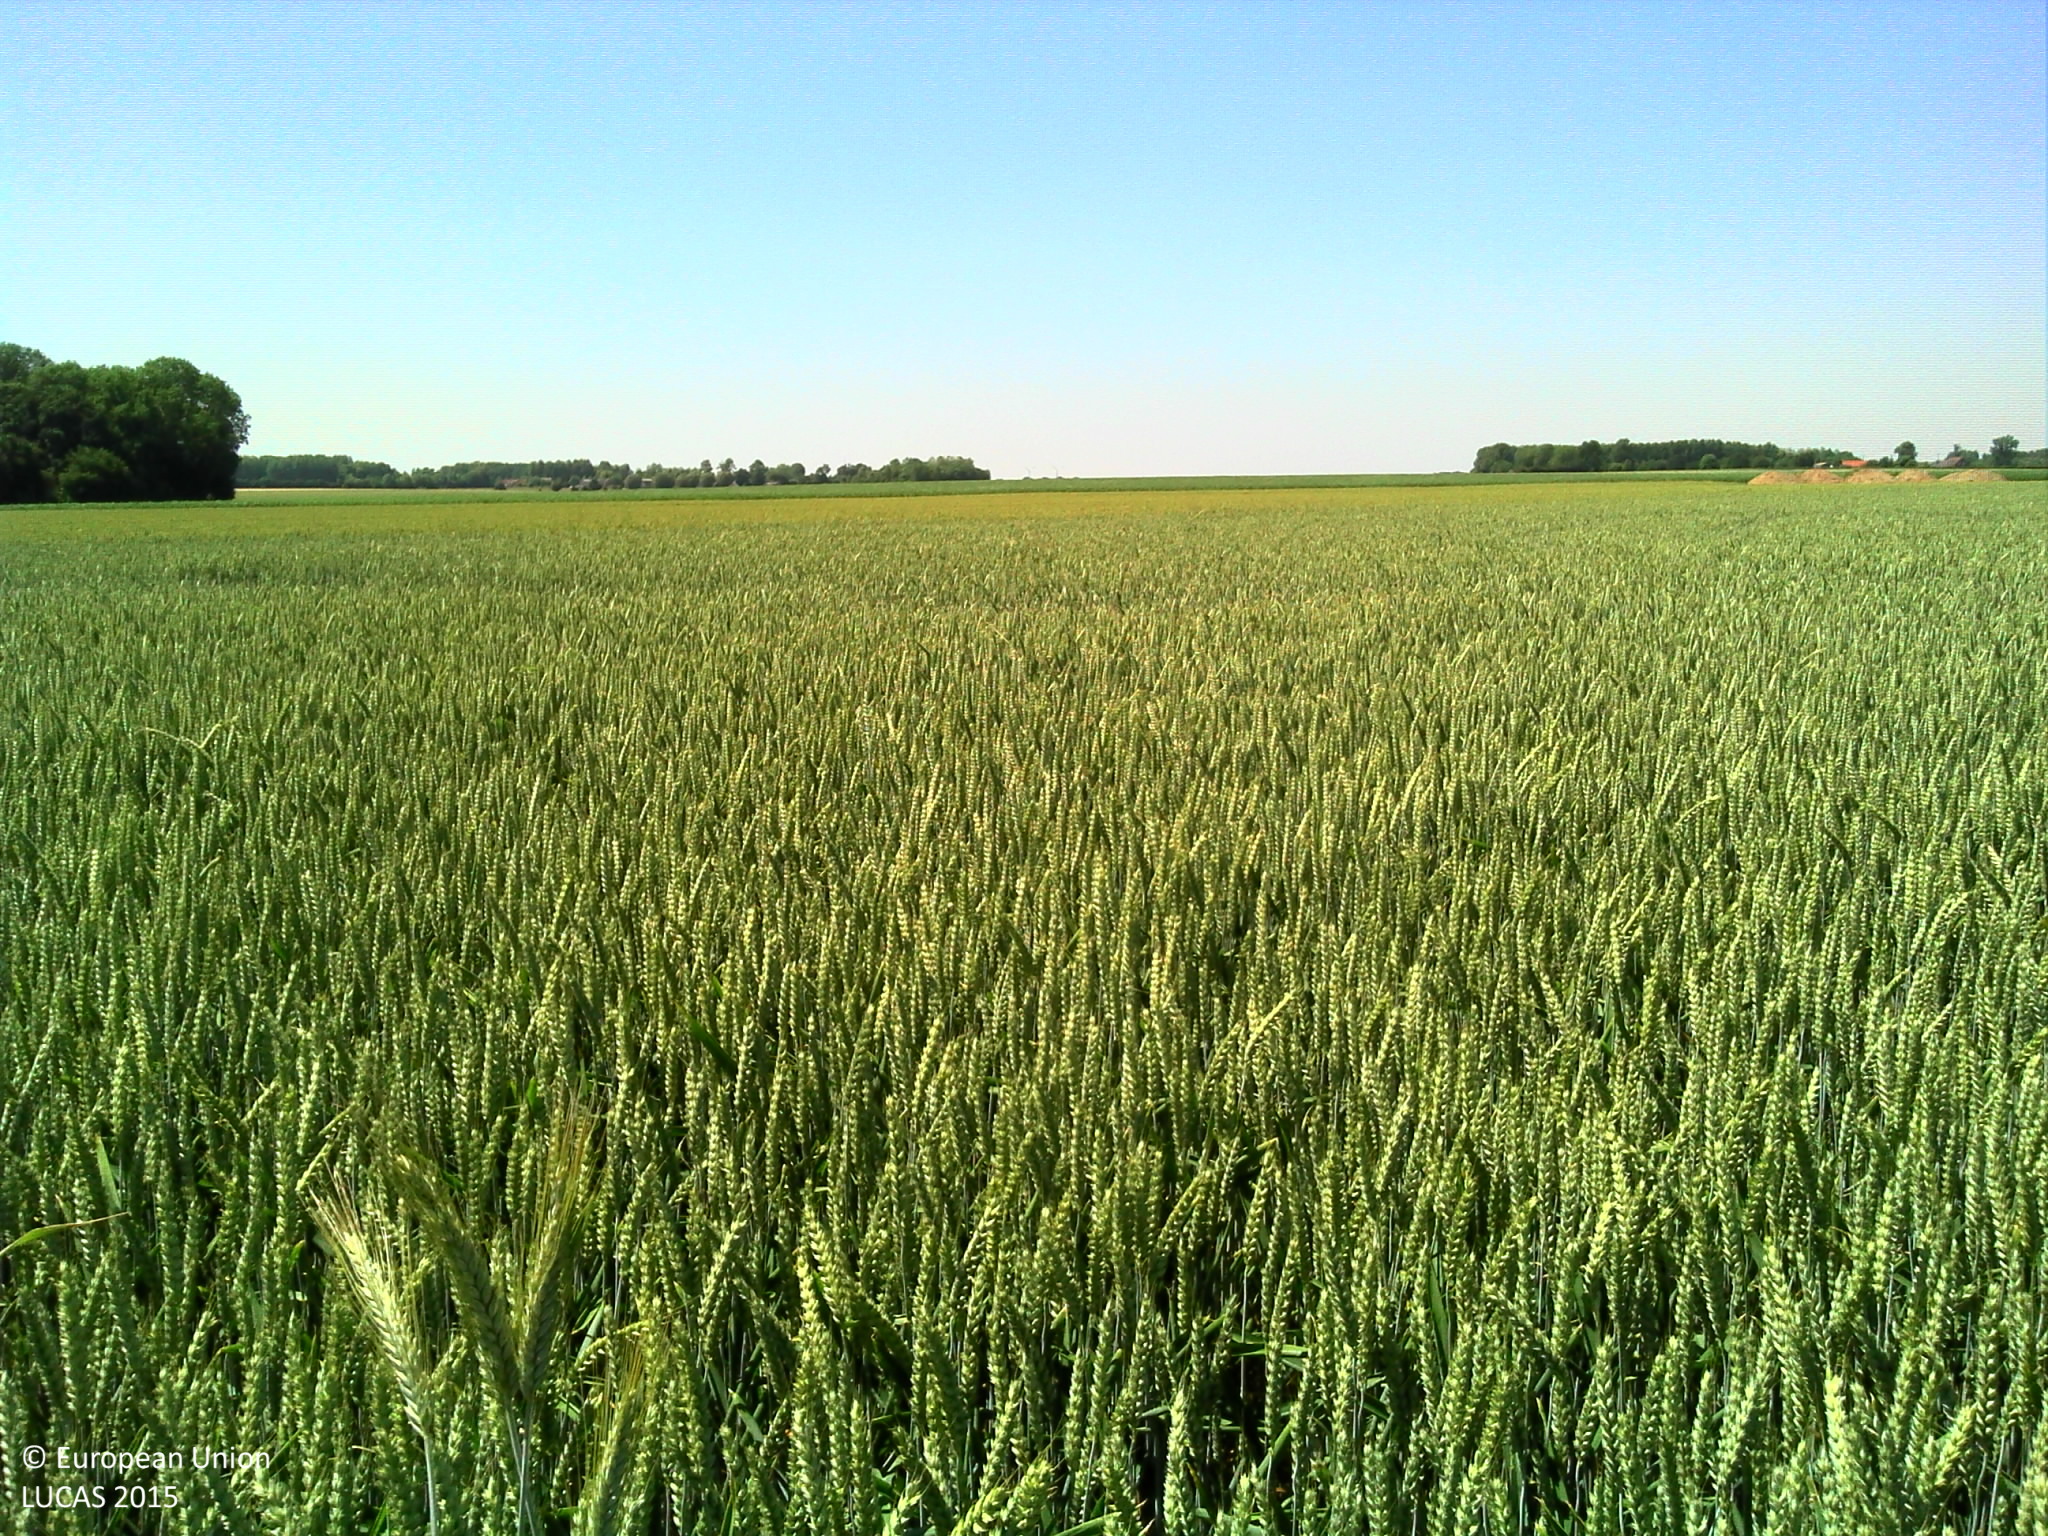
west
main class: Cropland
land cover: Common wheat
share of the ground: > 75 %
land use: Agriculture (excluding fallow land and kitchen gardens)
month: June
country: FR
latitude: 50.3269
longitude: 2.3874
